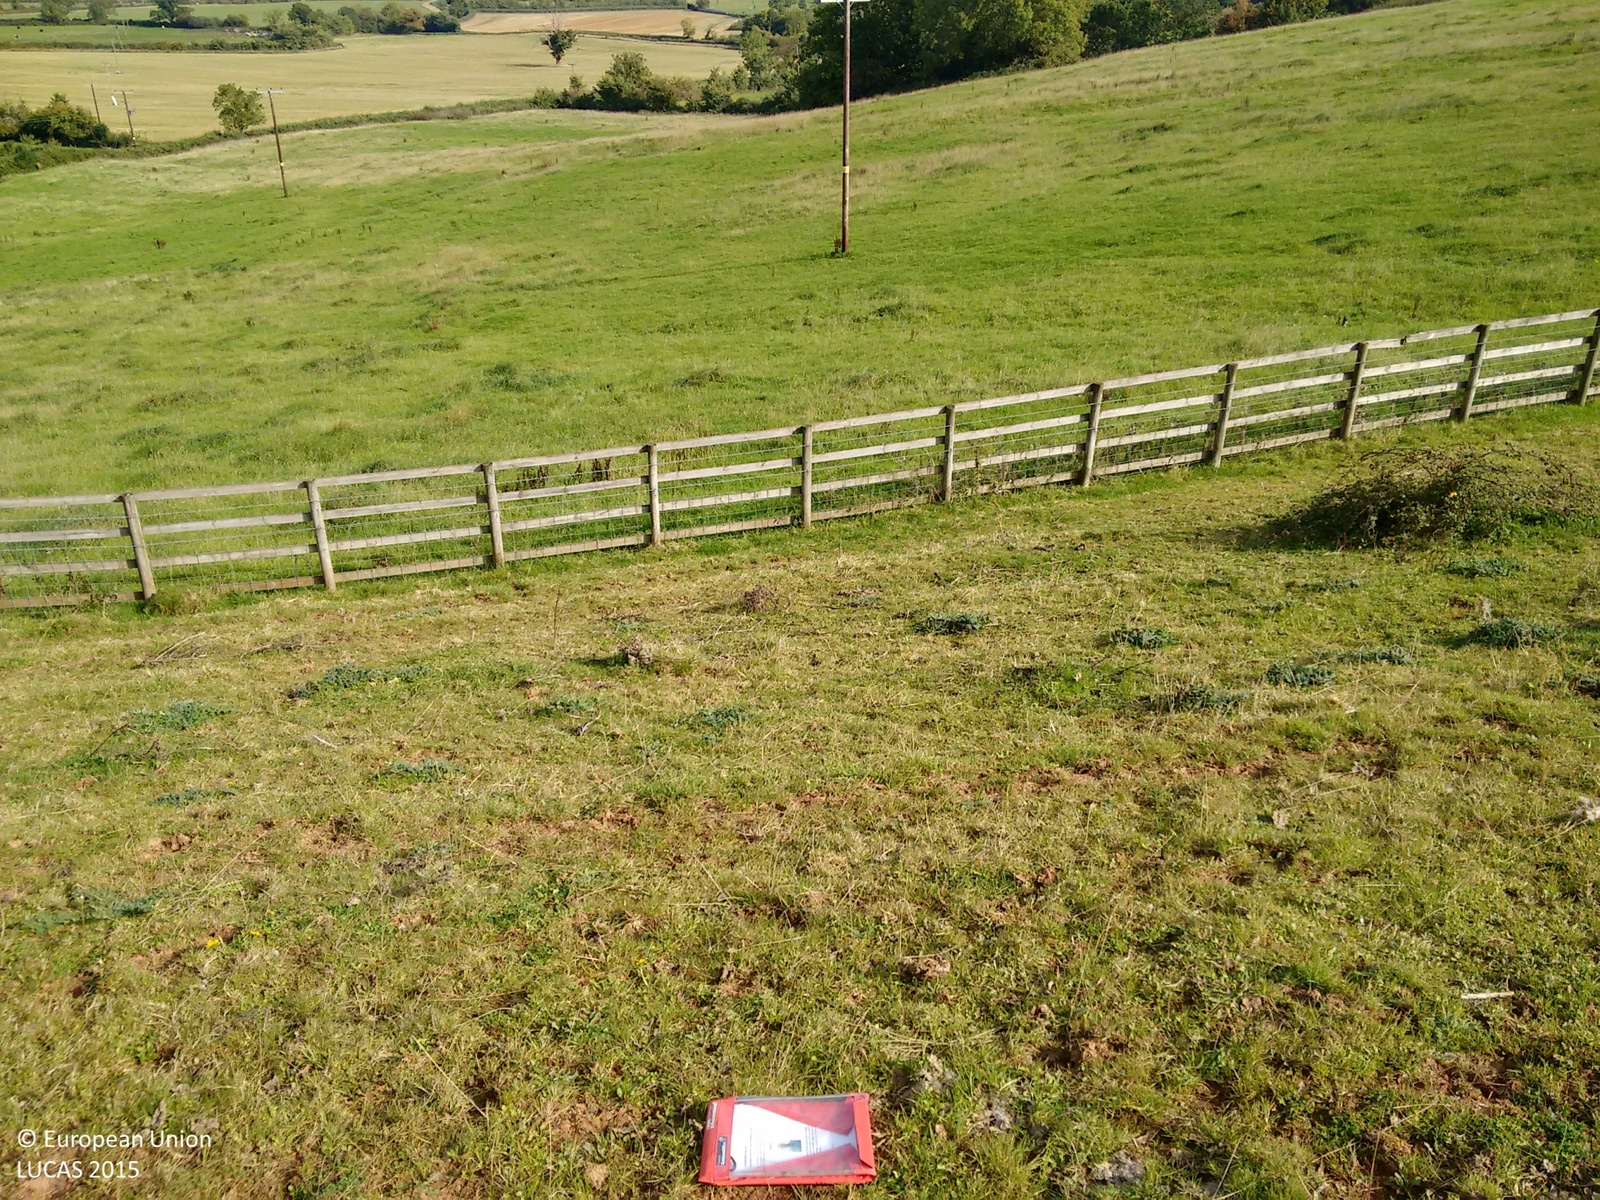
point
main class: Grassland
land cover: Grassland without tree/shrub cover
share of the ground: > 75 %
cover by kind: herbaceous plants 100 %
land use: Agriculture (excluding fallow land and kitchen gardens)
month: September
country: GB
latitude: 51.6783
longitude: -2.4893
